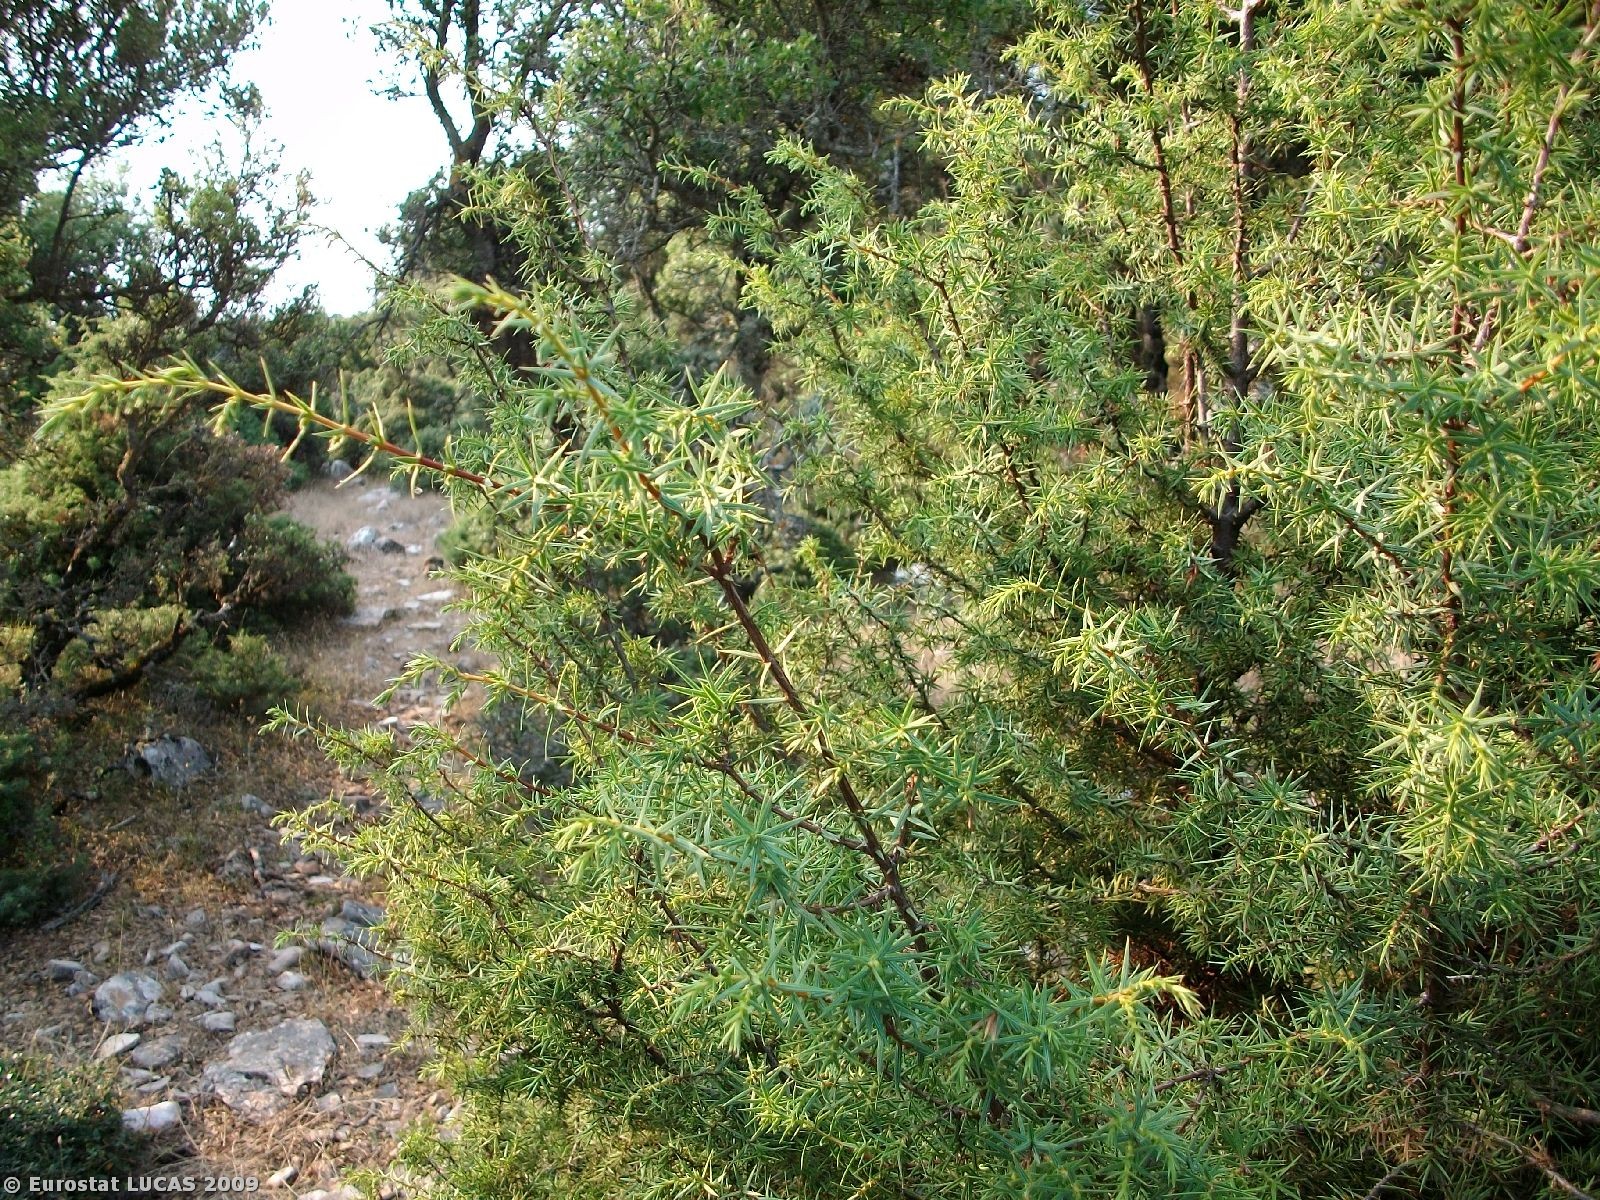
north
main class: Woodland
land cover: Broadleaved woodland
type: thermophilous deciduous forest
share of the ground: > 75 %
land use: Forestry
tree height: > 5 m
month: August
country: GR
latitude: 38.9562
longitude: 21.5954
